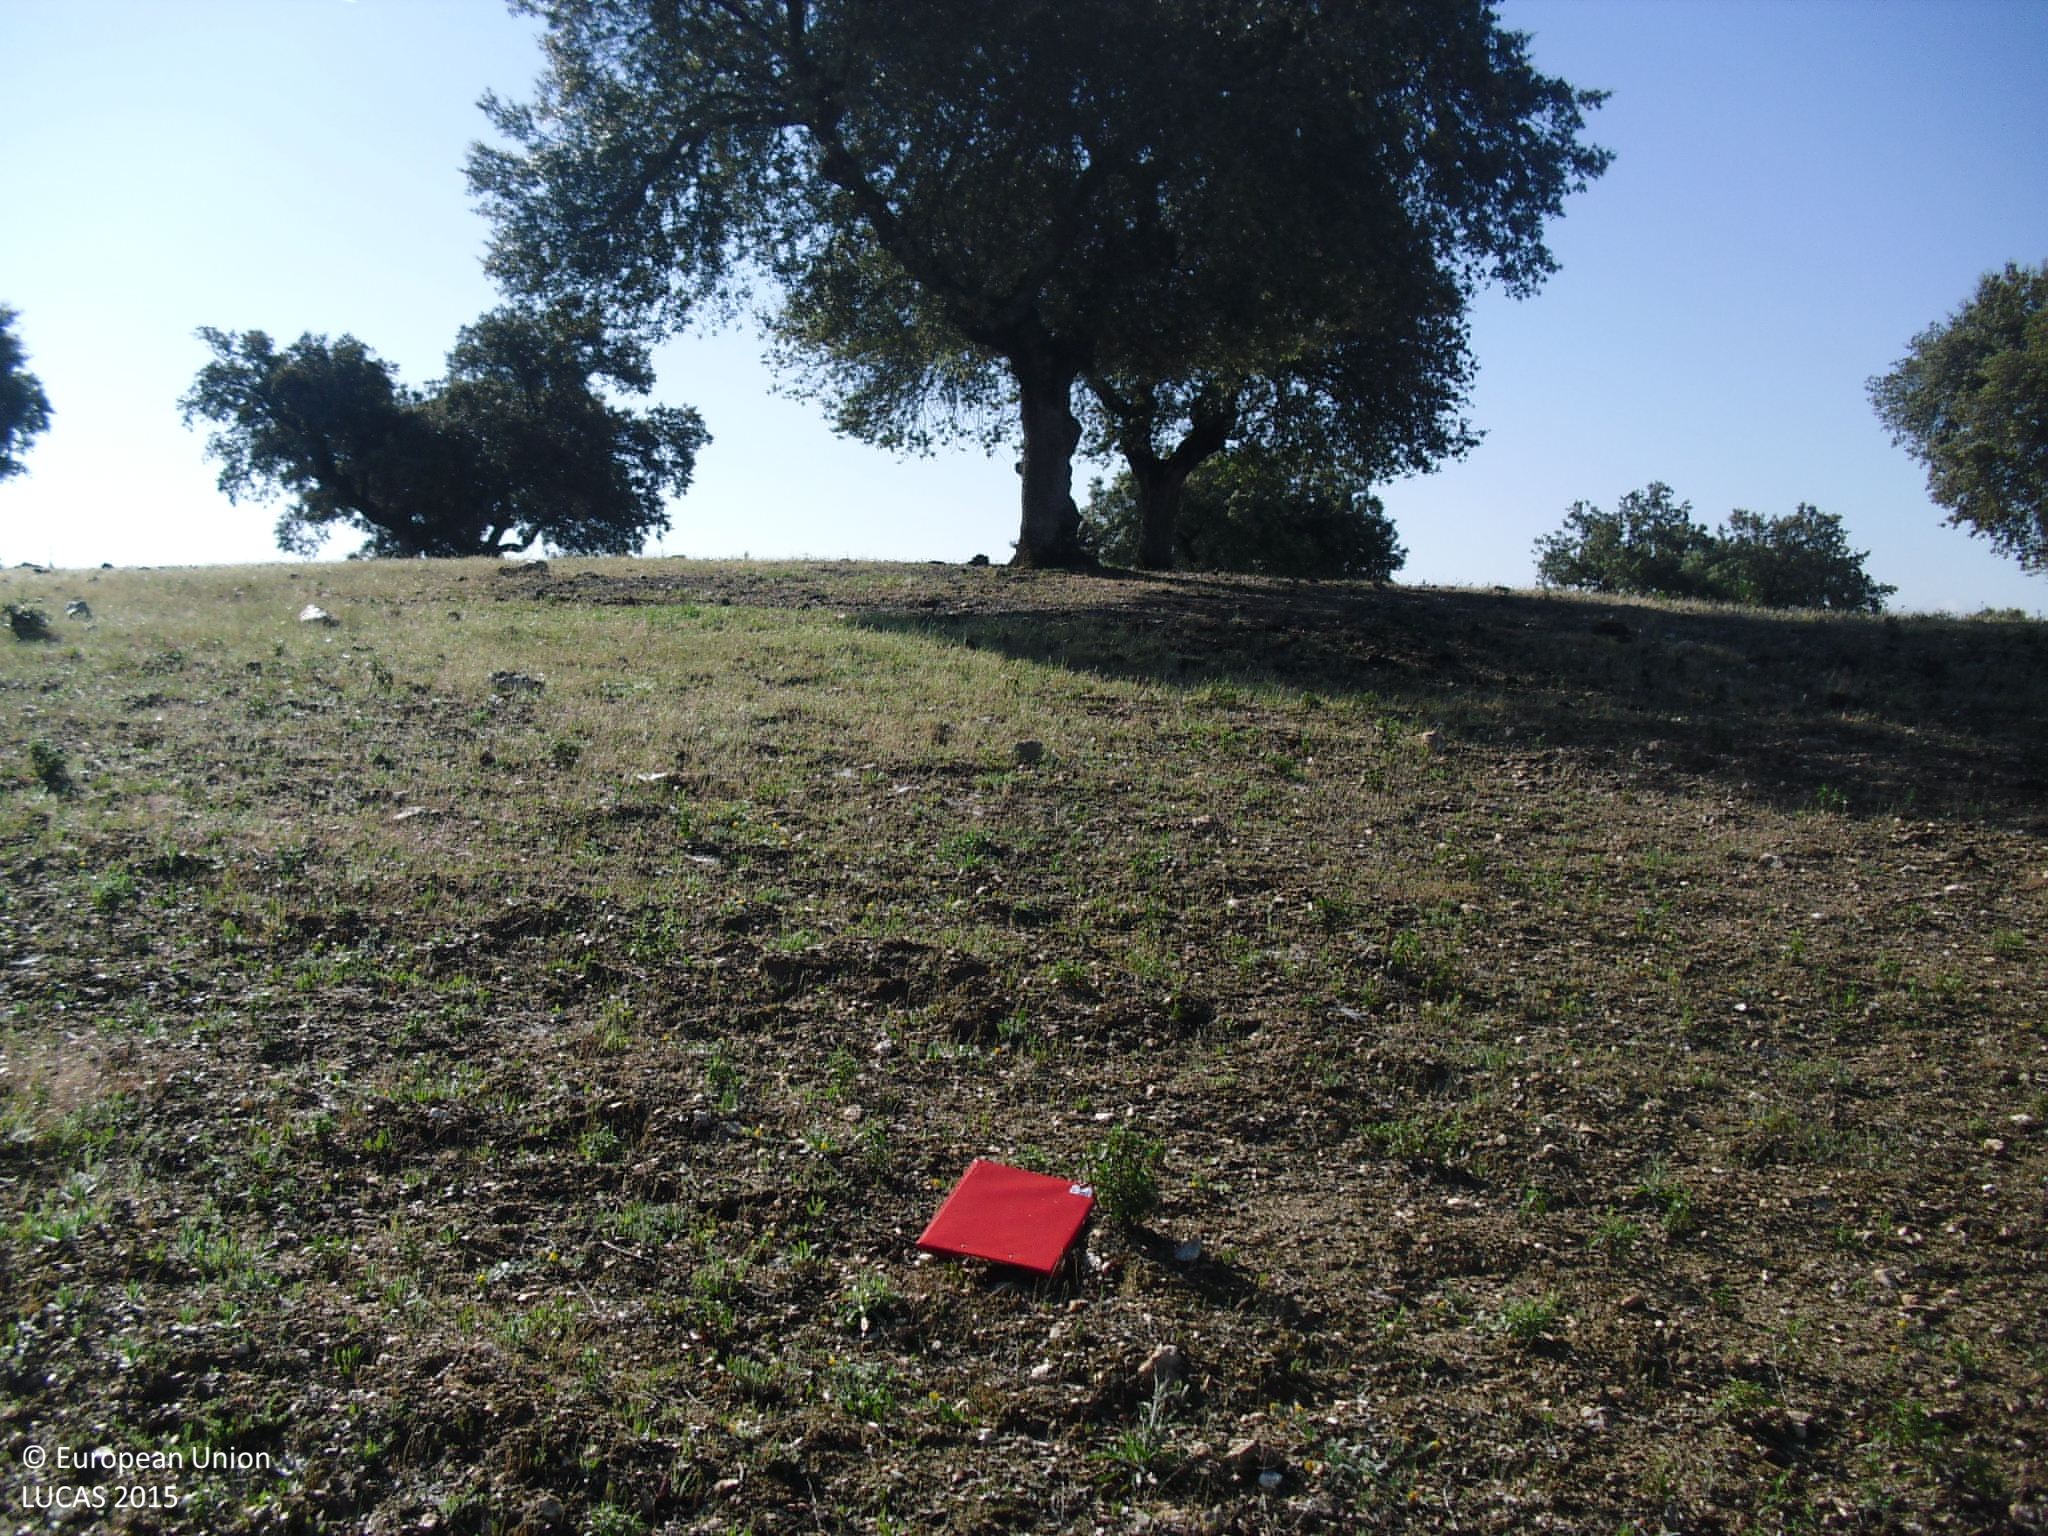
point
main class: Woodland
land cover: Broadleaved woodland
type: broadleaved evergreen forest
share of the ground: 10 - 25 %
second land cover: Spontaneously vegetated surfaces
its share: > 75 %
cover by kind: herbaceous plants 80 %, broadleaved forest trees 20 %
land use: Forestry
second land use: Agriculture (excluding fallow land and kitchen gardens)
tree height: > 5 m
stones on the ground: 10 - 25 %
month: April
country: ES
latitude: 39.5932
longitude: -7.4559
